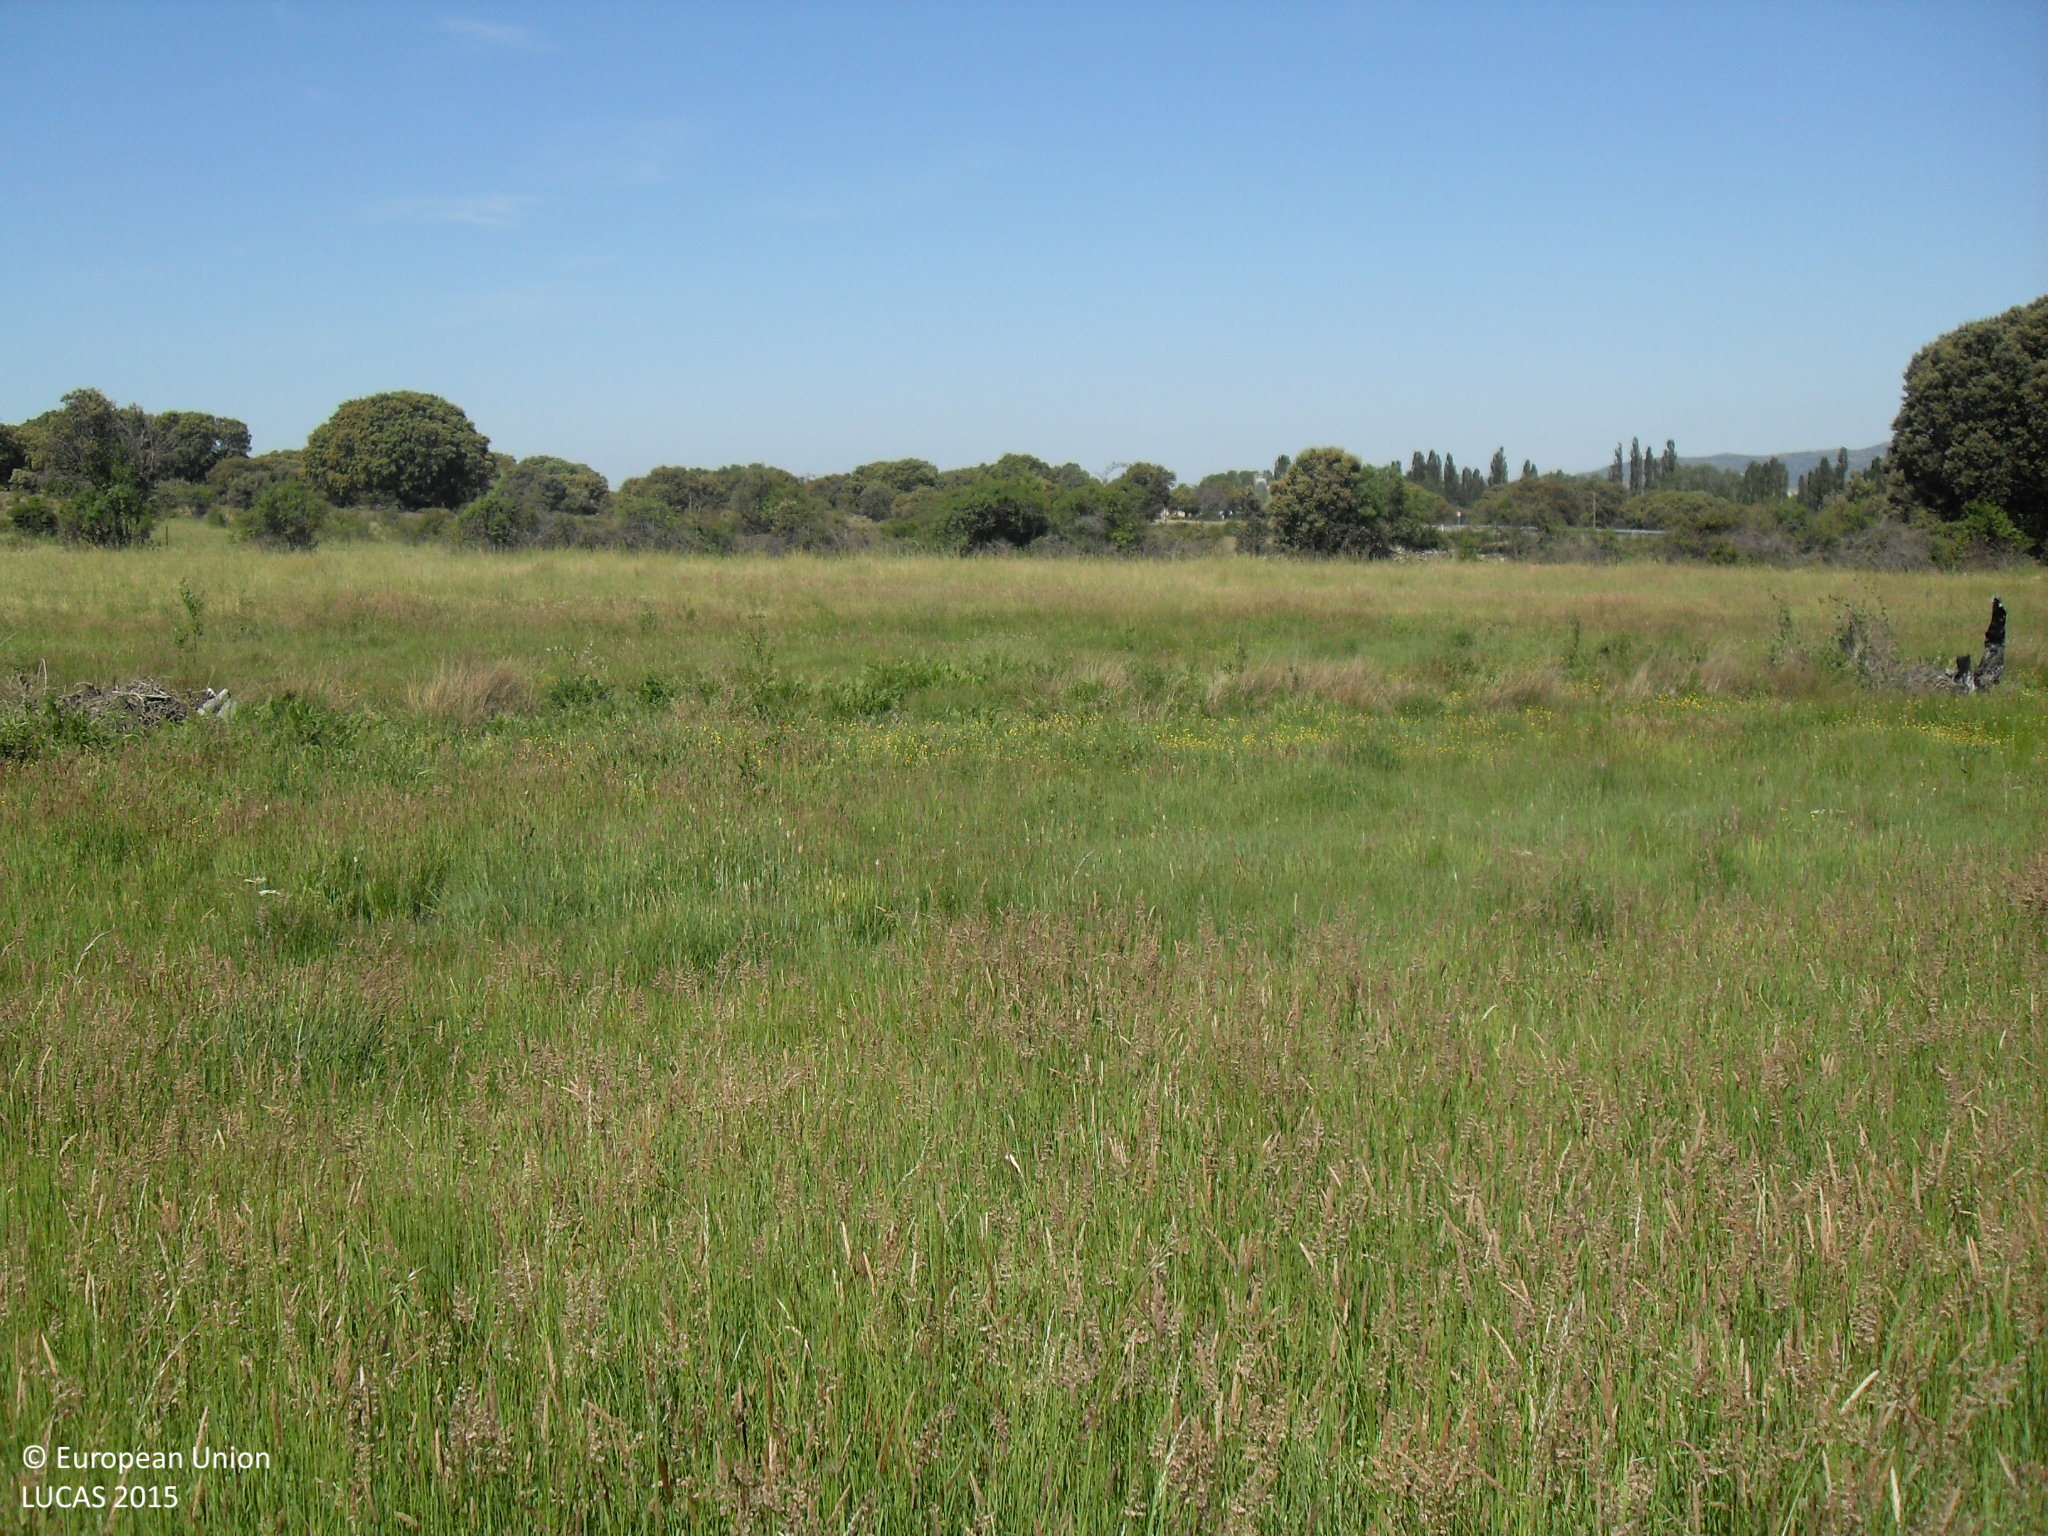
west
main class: Grassland
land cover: Grassland without tree/shrub cover
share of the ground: > 75 %
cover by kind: herbaceous plants 100 %
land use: Agriculture (excluding fallow land and kitchen gardens)
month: May
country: ES
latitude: 40.4967
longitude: -5.2723
